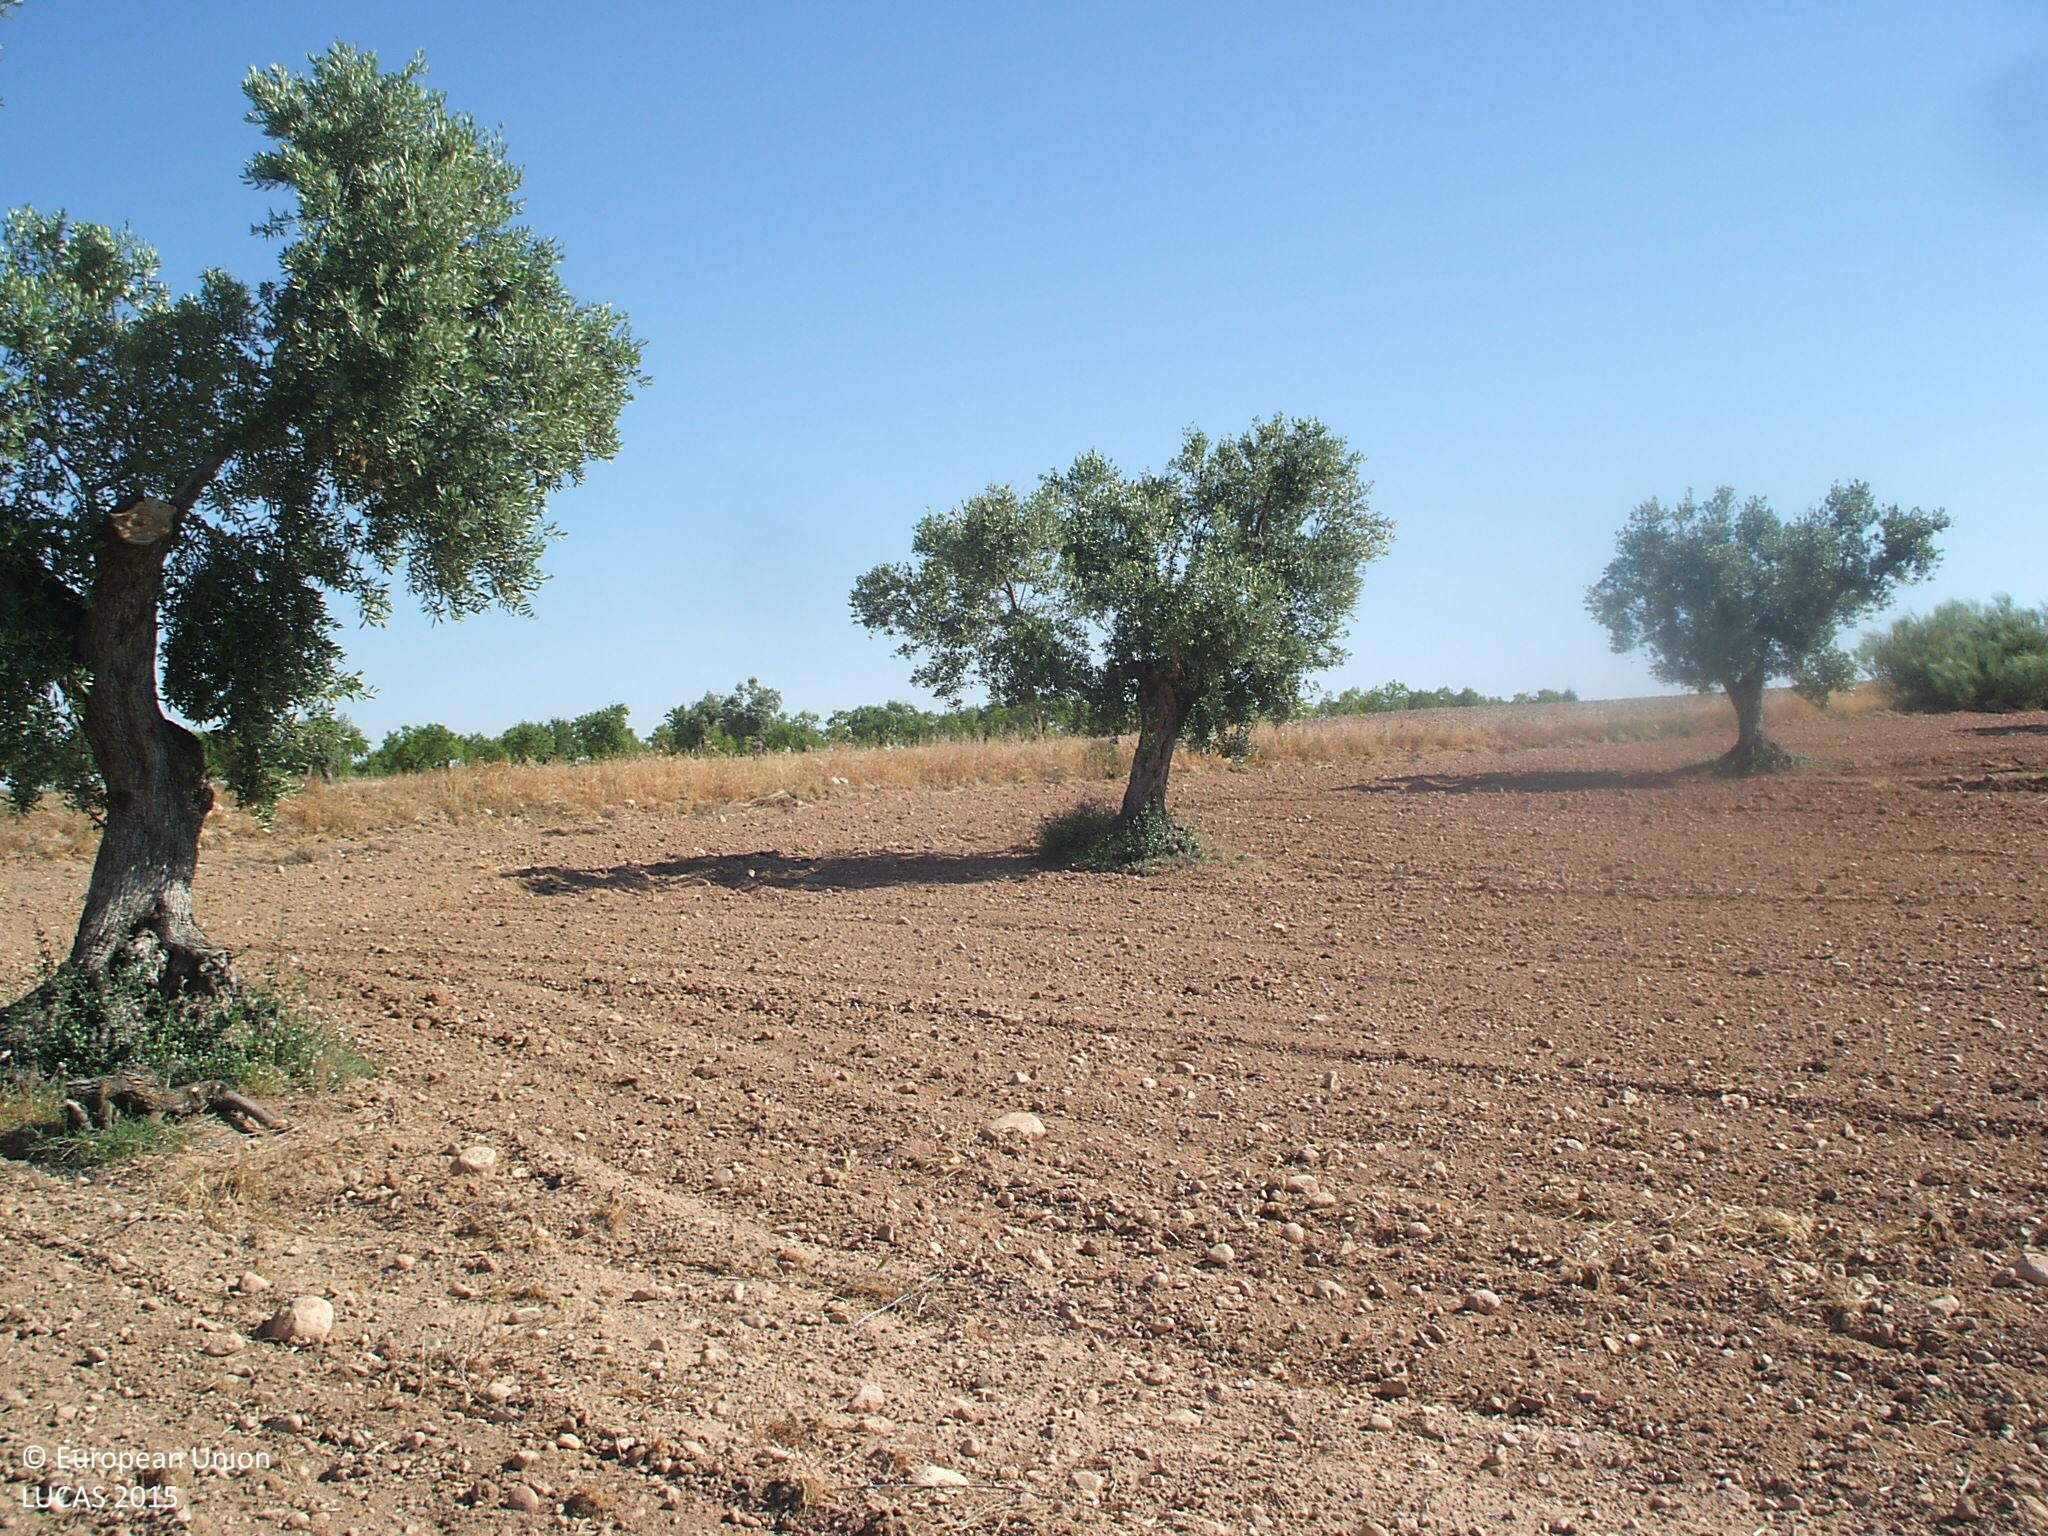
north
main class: Cropland
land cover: Olive groves
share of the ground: 10 - 25 %
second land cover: Other bare soil
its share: > 75 %
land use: Agriculture (excluding fallow land and kitchen gardens)
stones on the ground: > 50 %
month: June
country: ES
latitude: 41.0150
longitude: -0.3218
